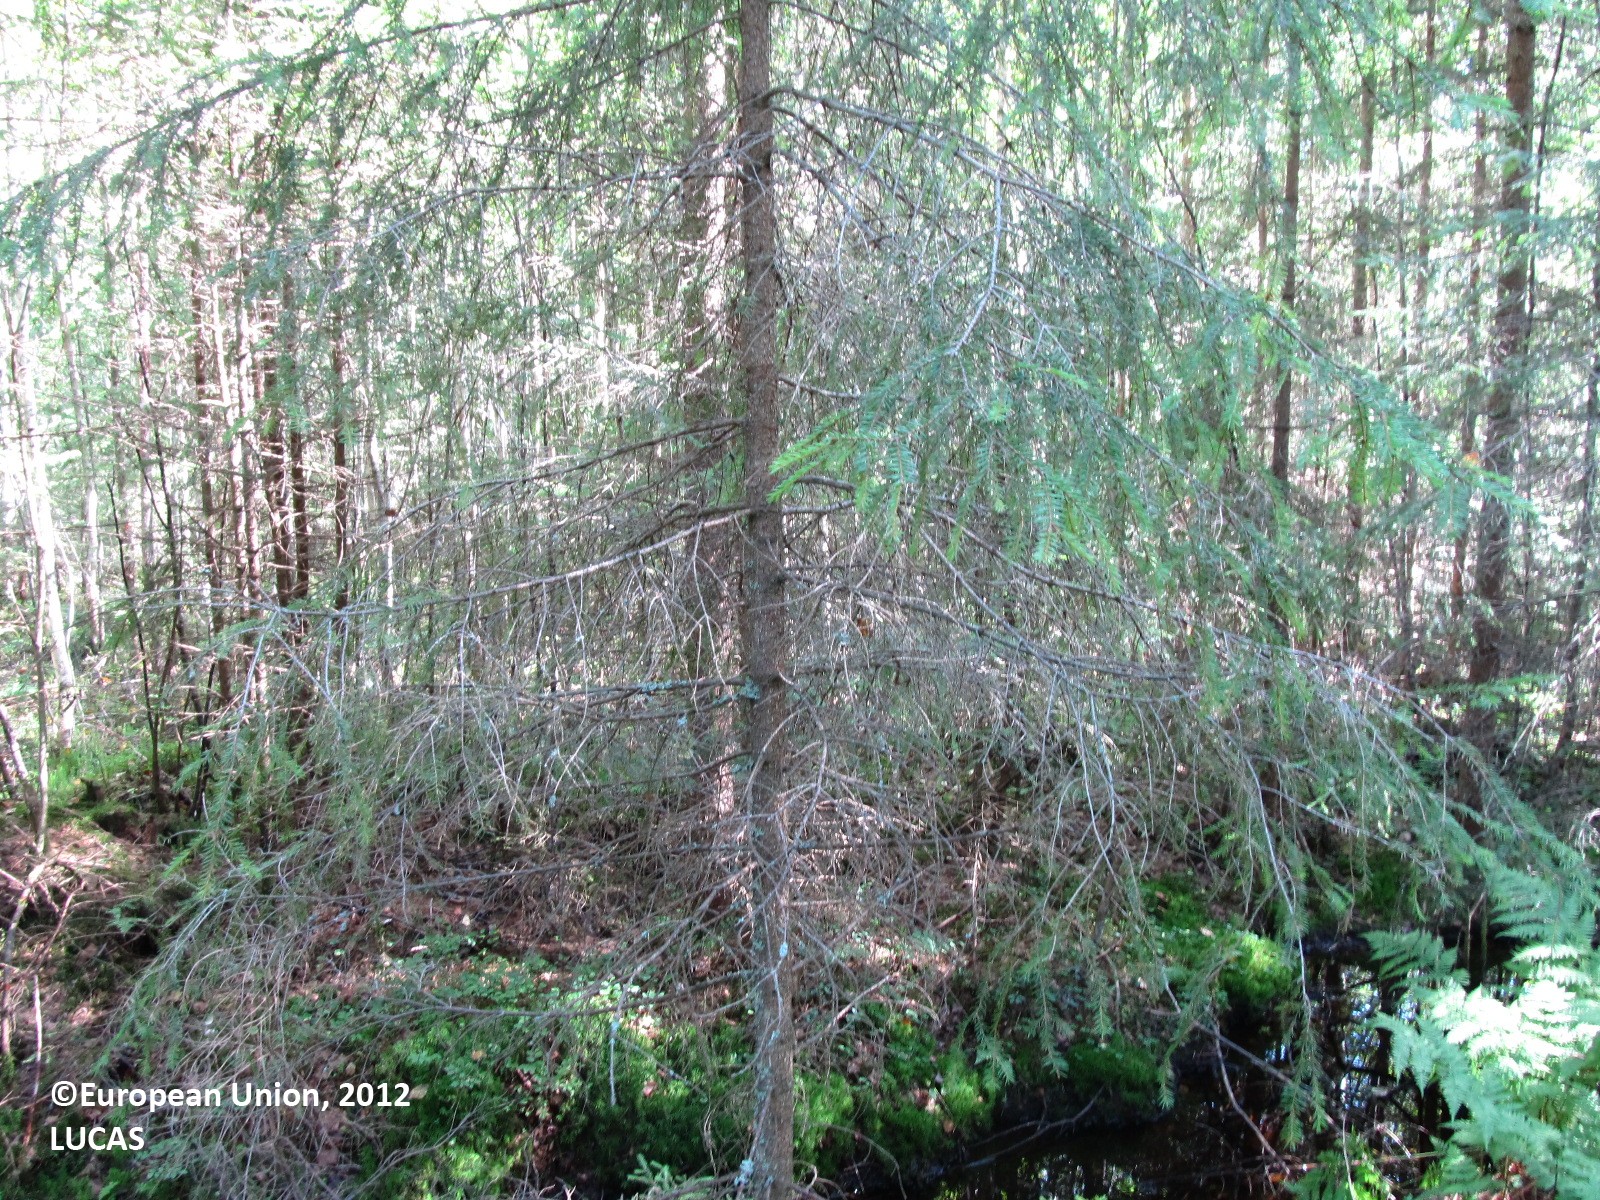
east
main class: Woodland
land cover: Spruce dominated coniferous woodland
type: boreal forest
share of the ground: 50 - 75 %
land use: Forestry
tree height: > 5 m
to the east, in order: Spruce dominated coniferous woodland; Ditches and canals; Spruce dominated coniferous woodland; Broadleaved woodland; Electric lines; Barley
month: August
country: FI
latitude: 62.3010
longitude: 27.7852
